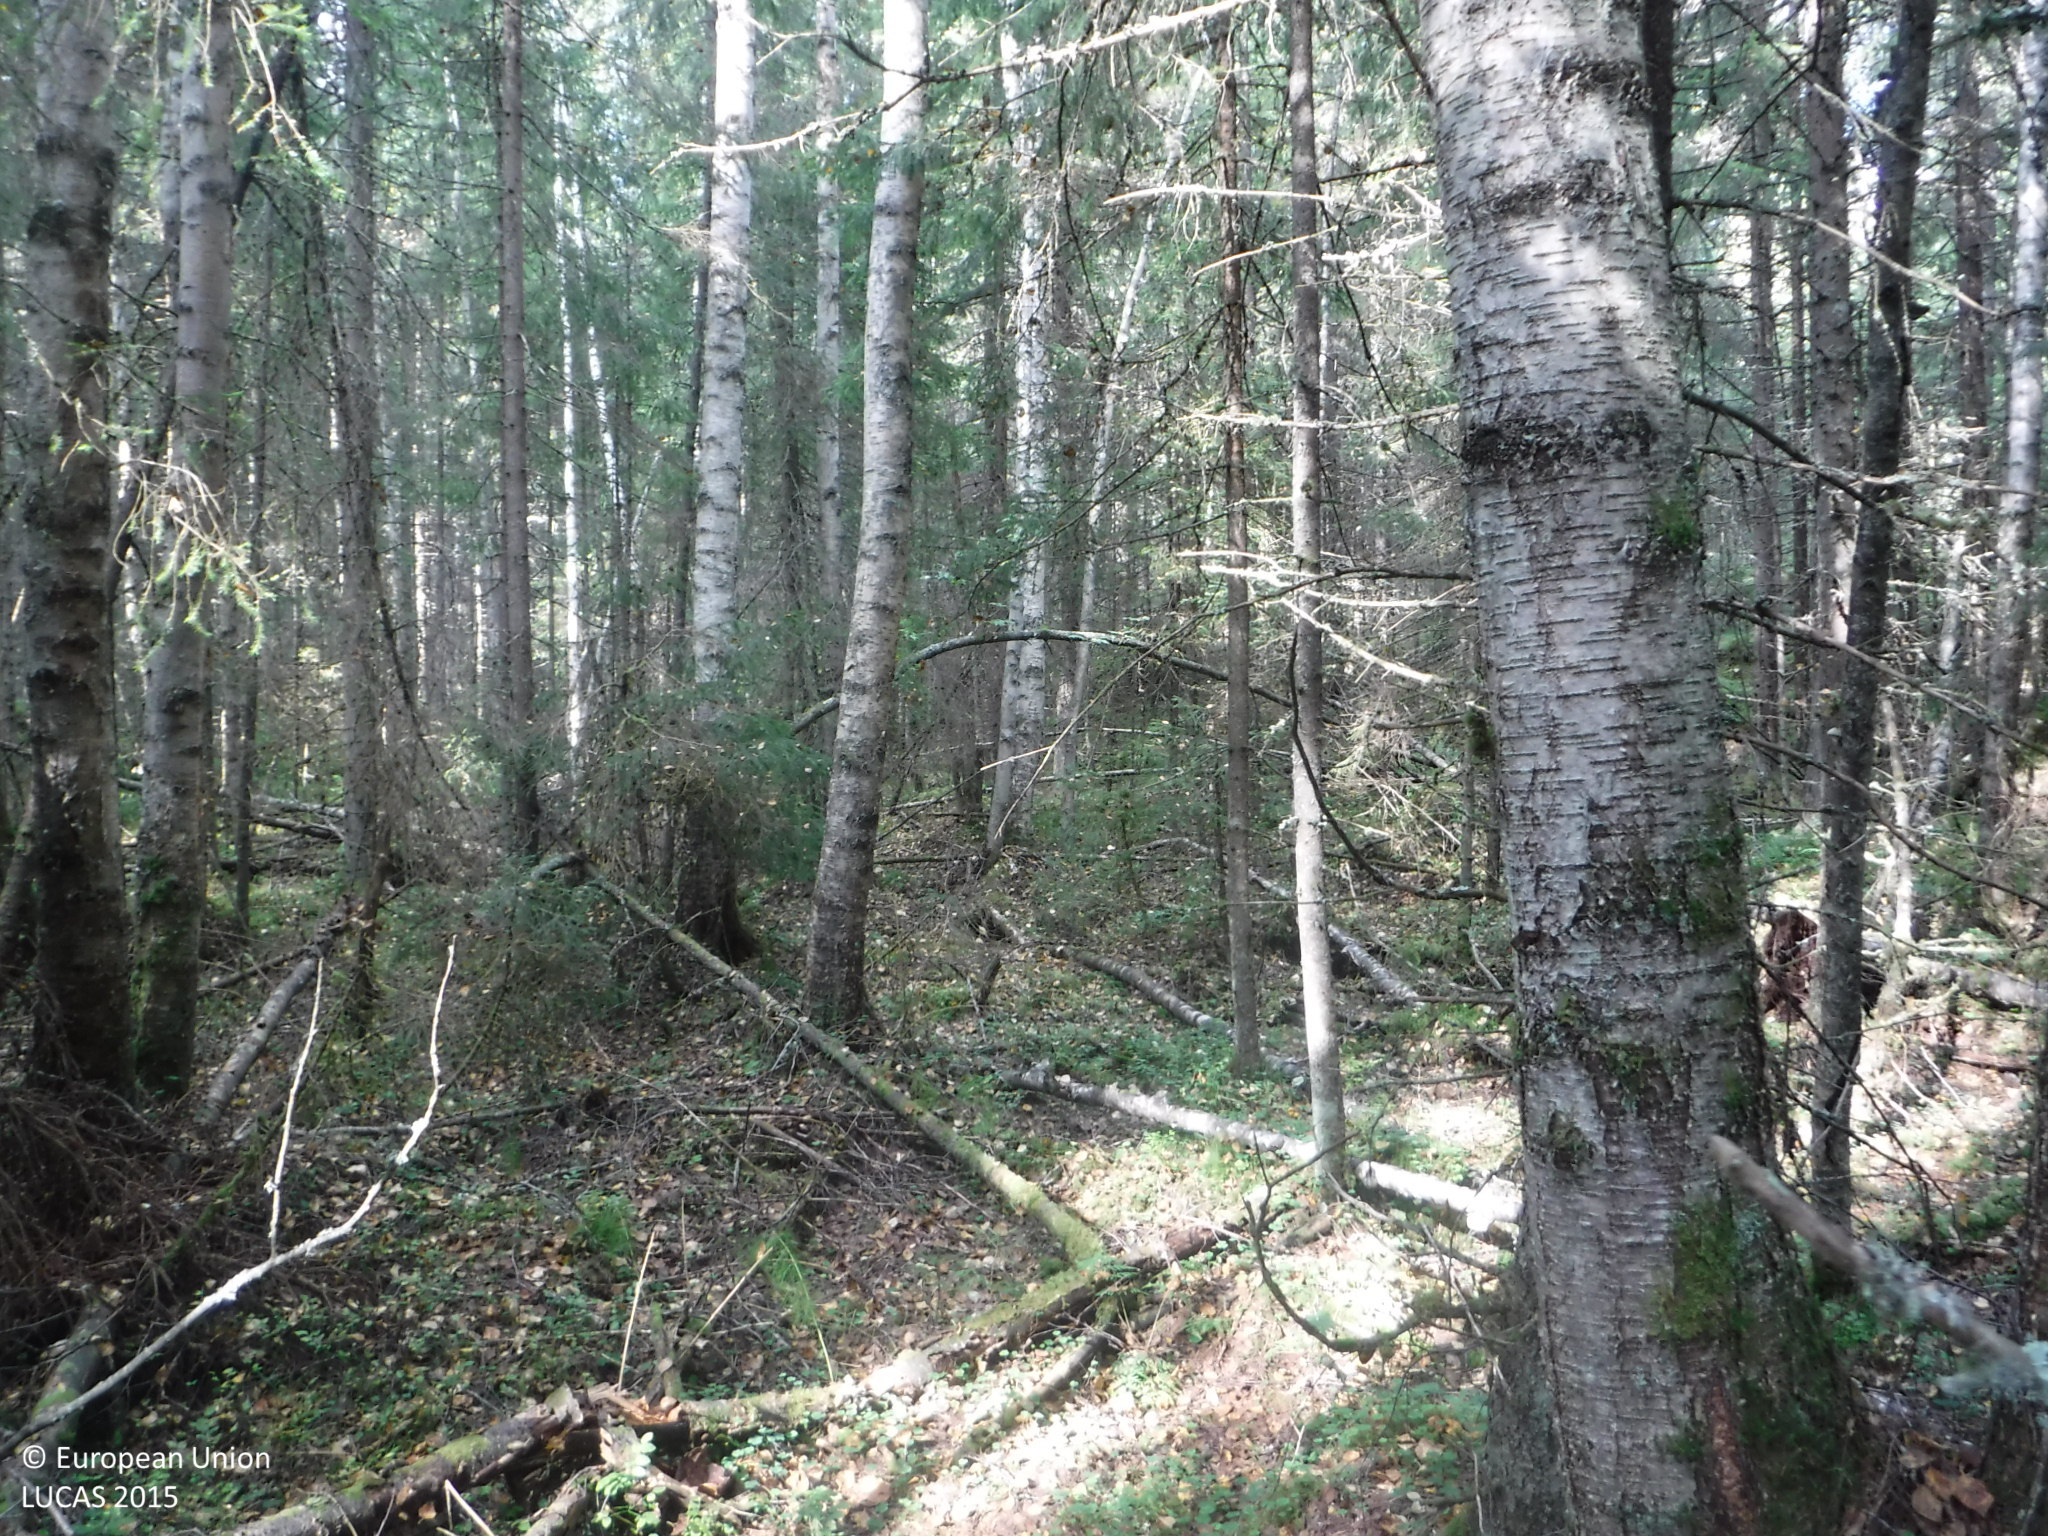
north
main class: Woodland
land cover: Spruce dominated mixed woodland
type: boreal forest
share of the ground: > 75 %
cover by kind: coniferous forest trees 45 %, broadleaved forest trees 30 %, herbaceous plants 15 %, lichens and mosses 10 %
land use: Forestry
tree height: > 5 m
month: September
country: FI
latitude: 61.6979
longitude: 22.3685
